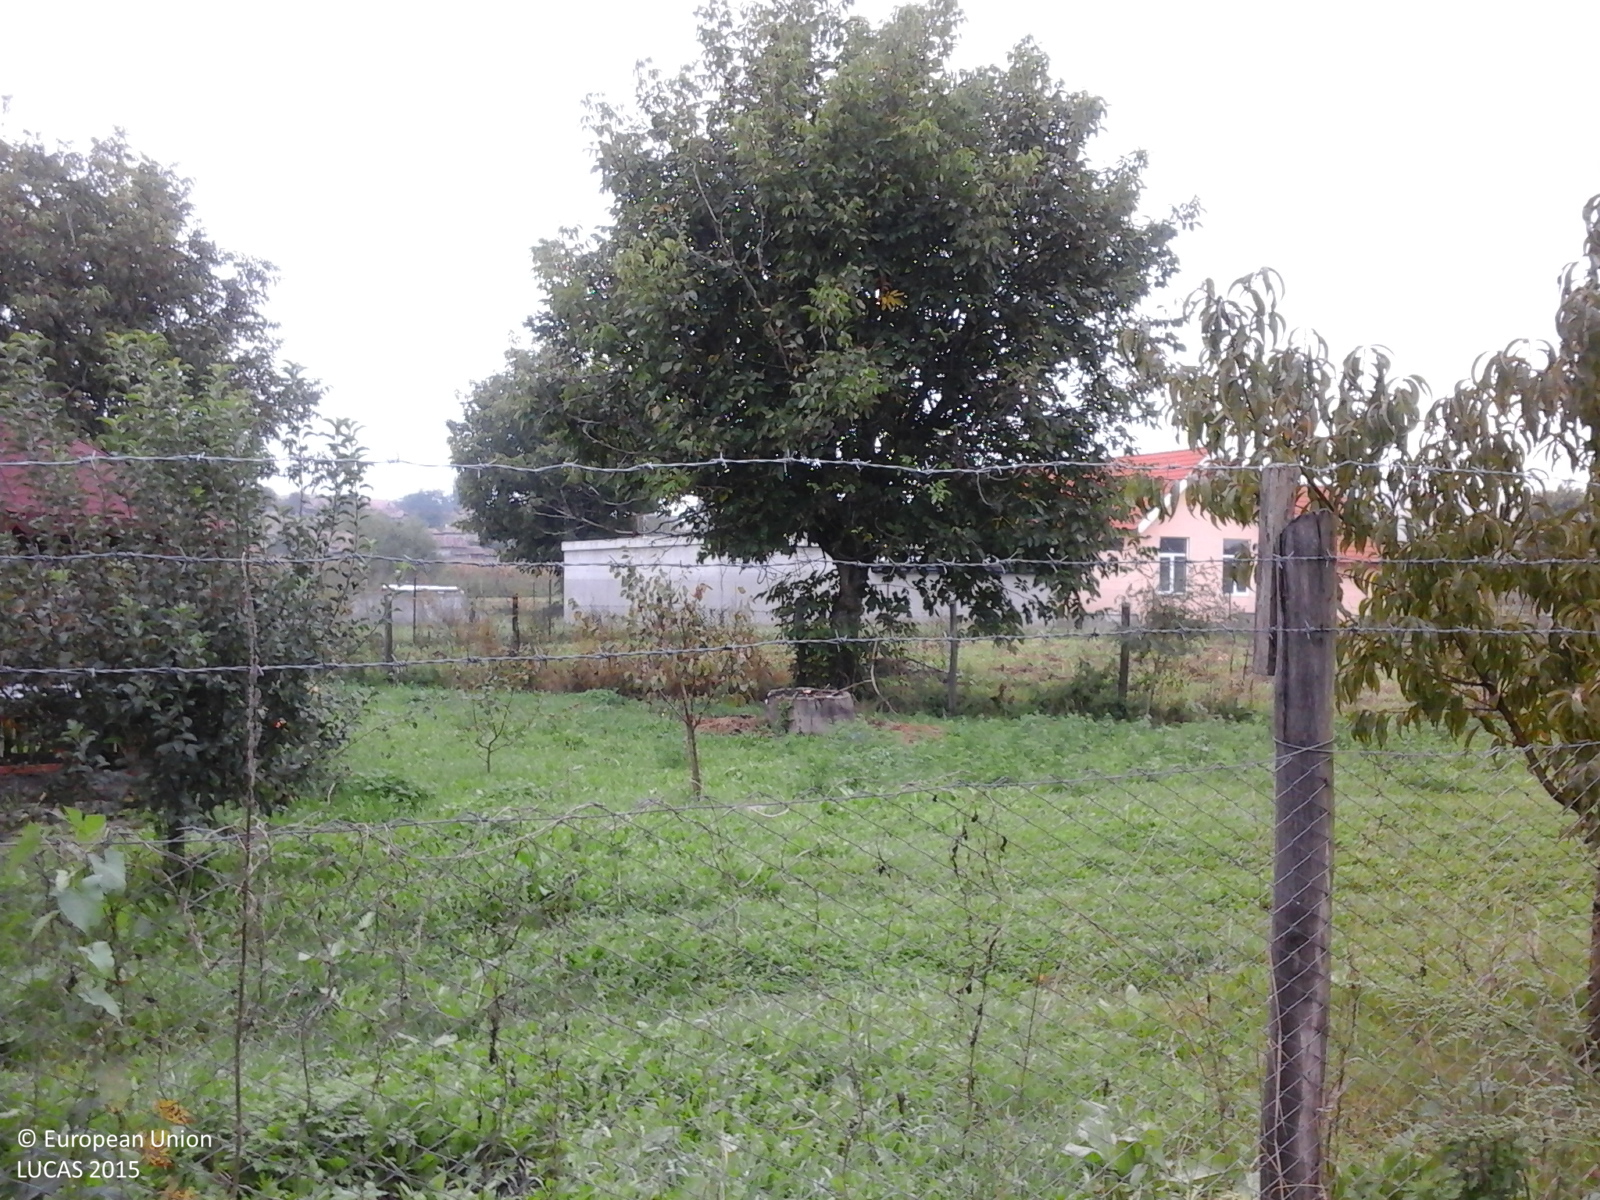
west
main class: Cropland
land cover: Maize
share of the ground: > 75 %
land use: Agriculture (excluding fallow land and kitchen gardens)
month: October
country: RO
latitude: 46.6865
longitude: 24.4032
